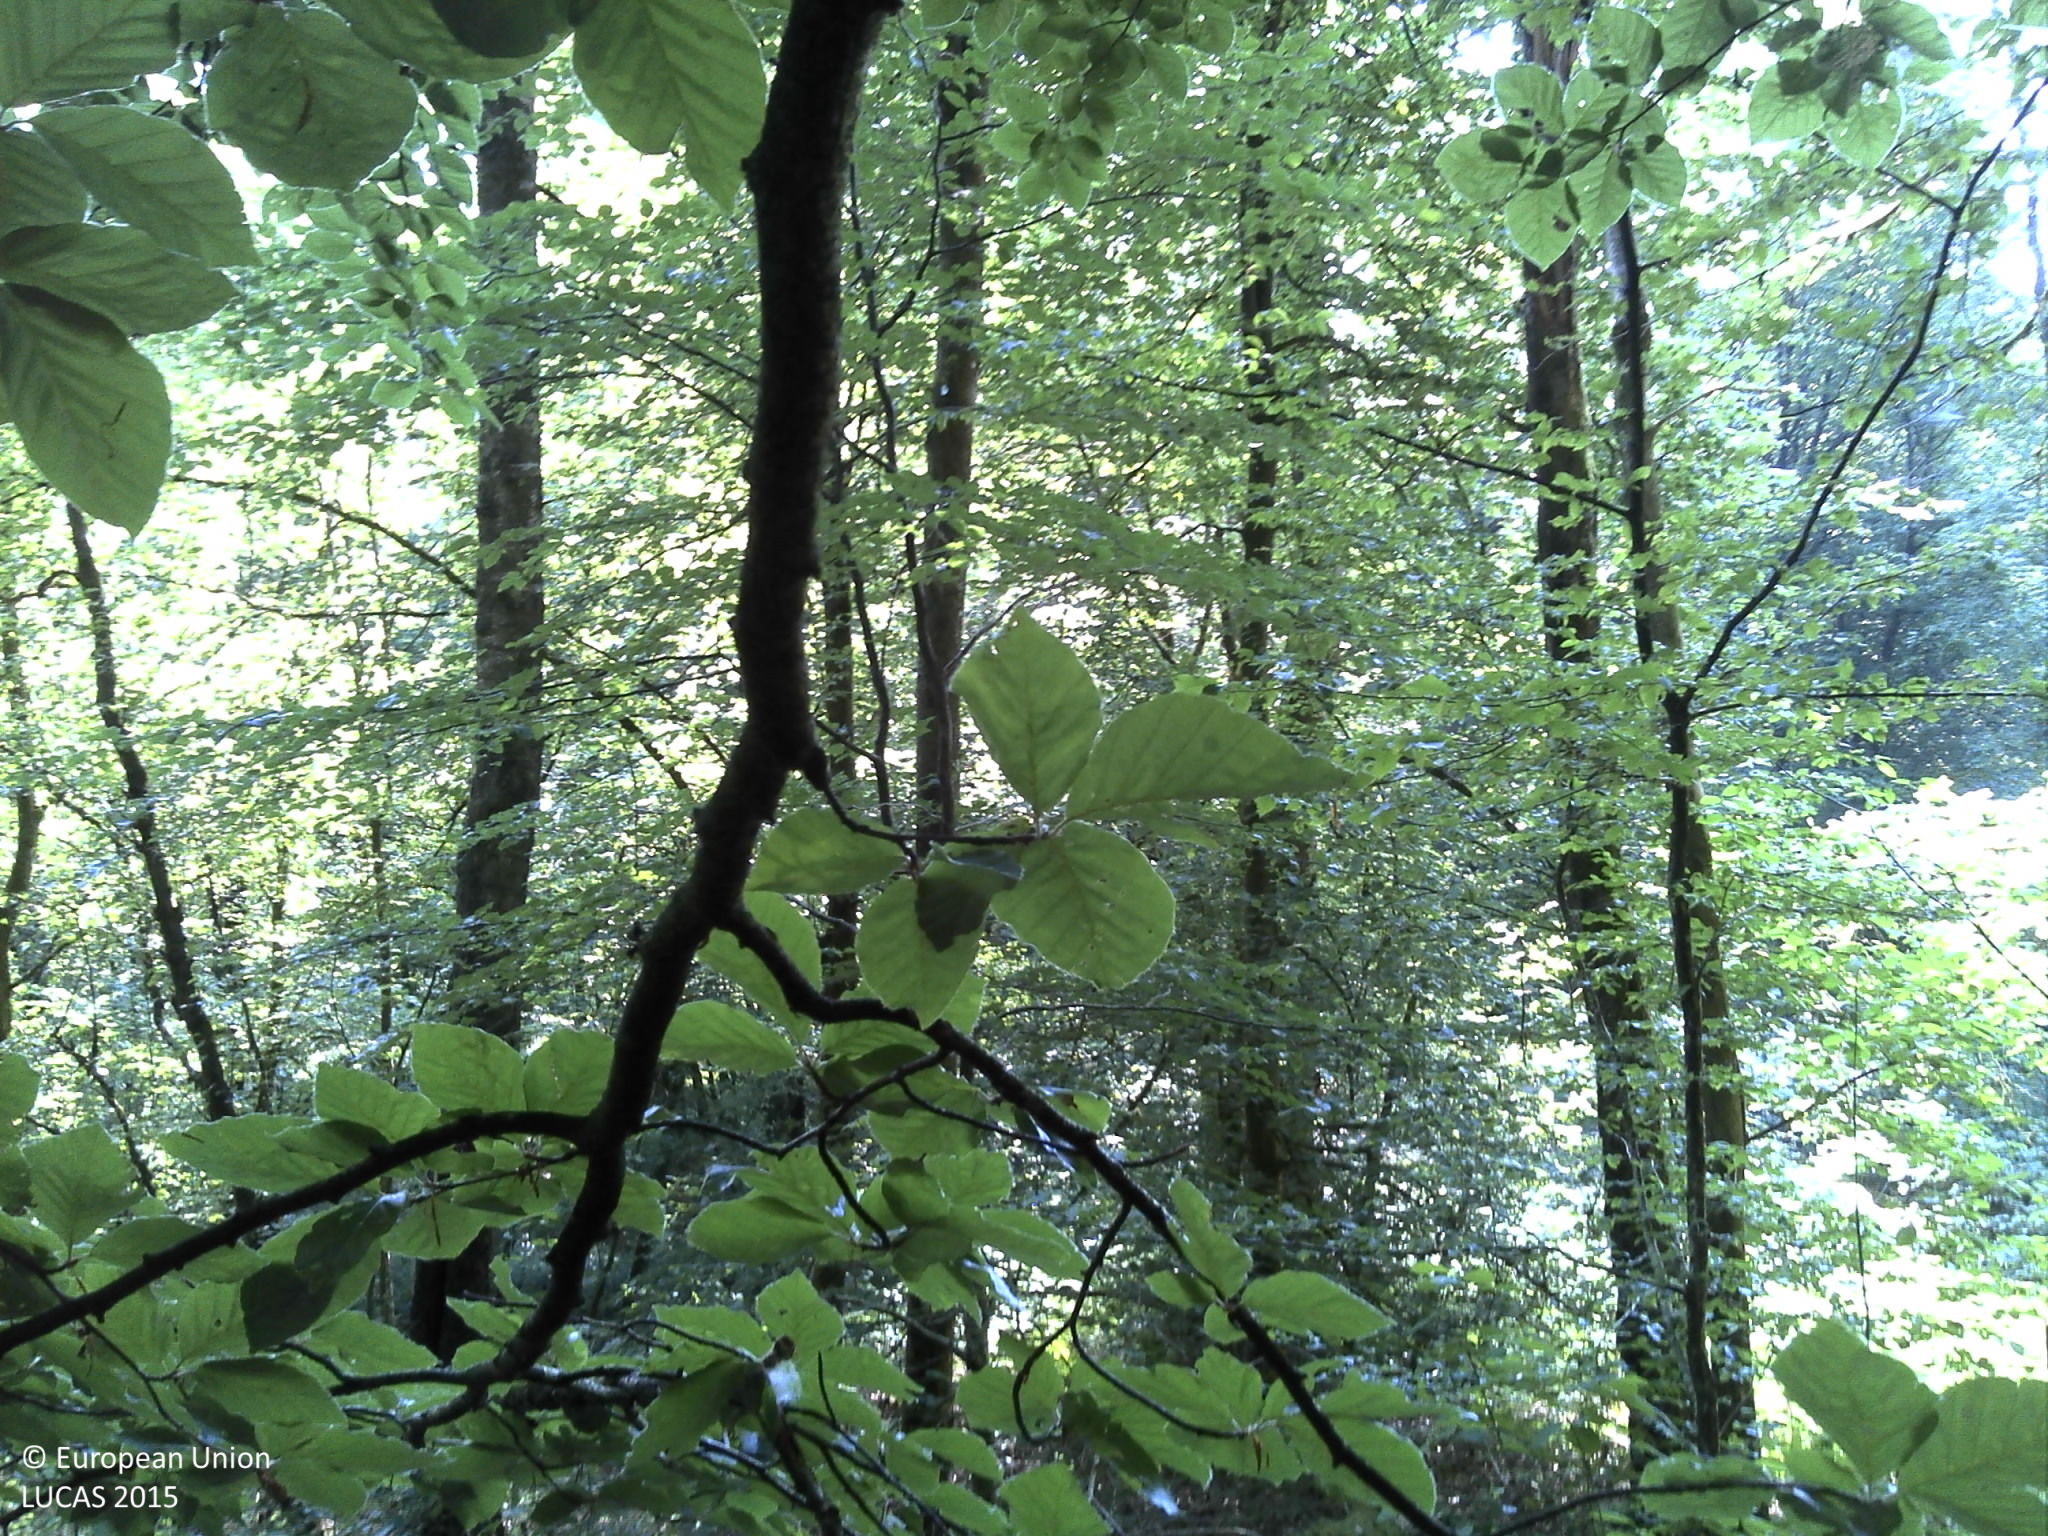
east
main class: Woodland
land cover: Broadleaved woodland
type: beech forest
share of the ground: 50 - 75 %
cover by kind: broadleaved forest trees 70 %, herbaceous plants 20 %, lichens and mosses 5 %, consolidated bare surface 5 %
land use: Forestry
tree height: > 5 m
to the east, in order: Broadleaved woodland; Tracks; Broadleaved woodland
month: July
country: FR
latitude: 49.9111
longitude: 4.5793
